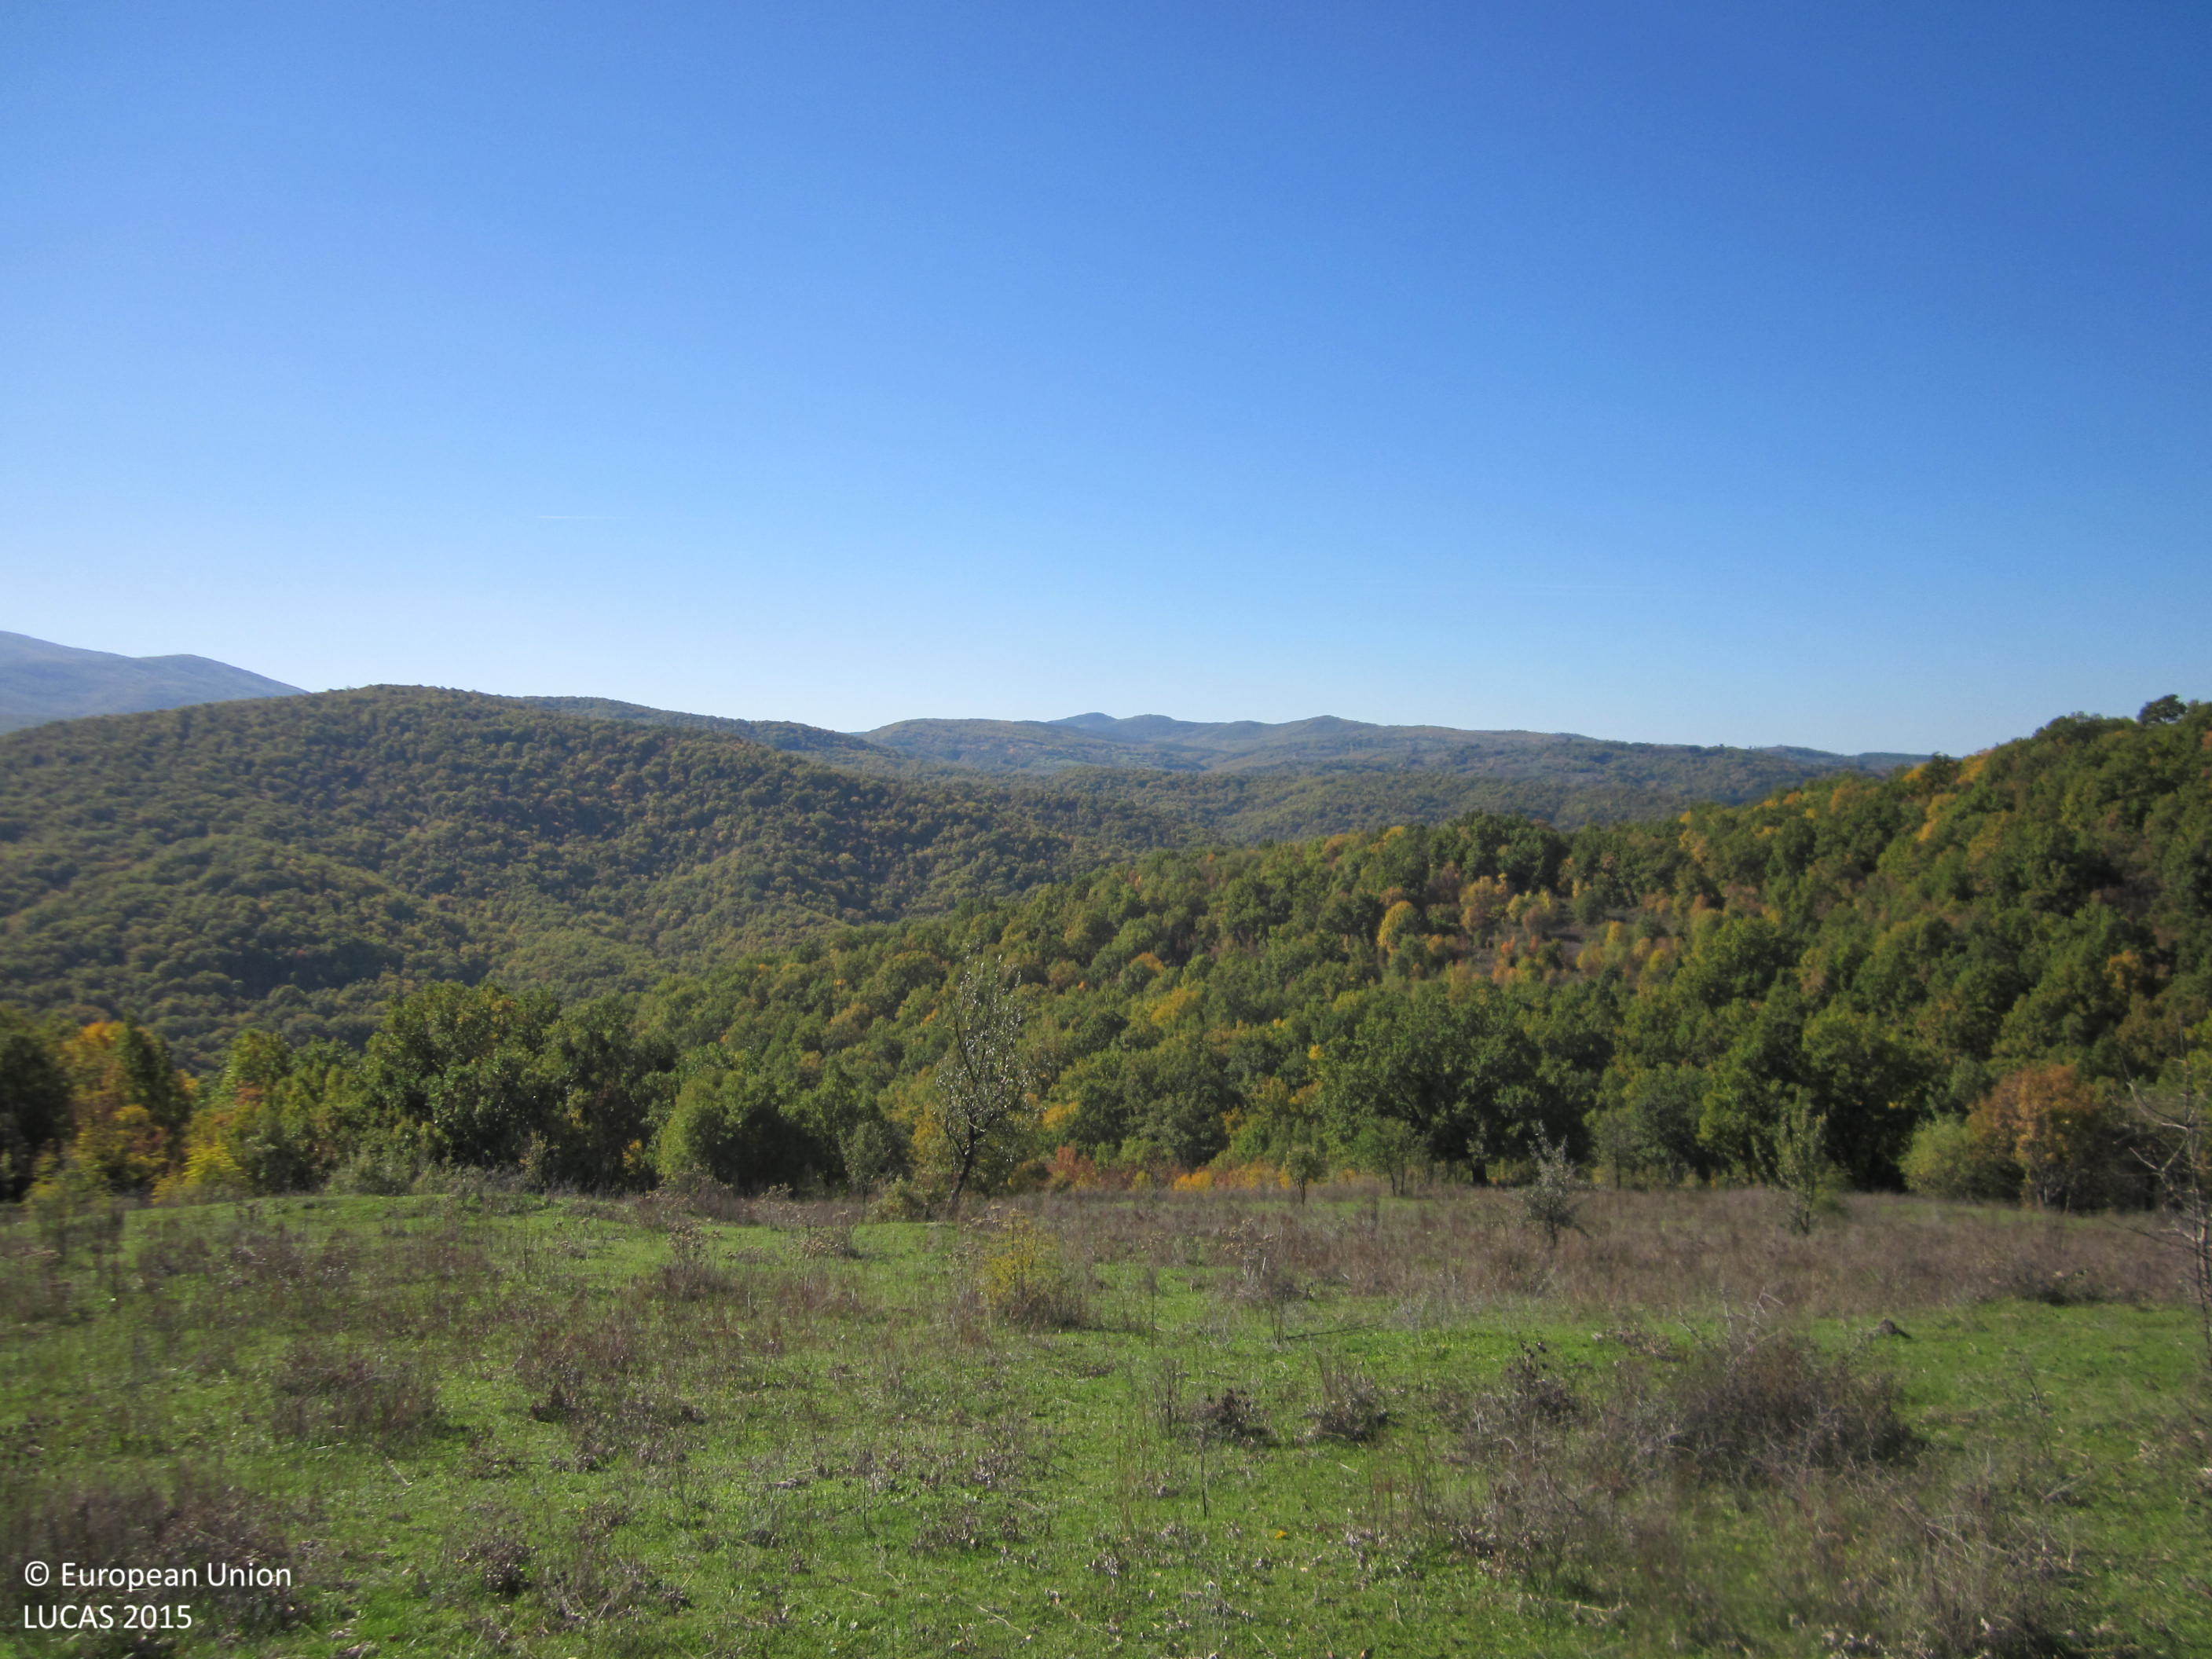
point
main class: Woodland
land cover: Broadleaved woodland
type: hemiboreal forest and nemoral coniferous forest and mixed broadleaved-coniferous forest
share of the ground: > 75 %
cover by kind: broadleaved forest trees 100 %
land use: Forestry
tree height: > 5 m
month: November
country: BG
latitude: 41.4337
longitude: 25.8485
